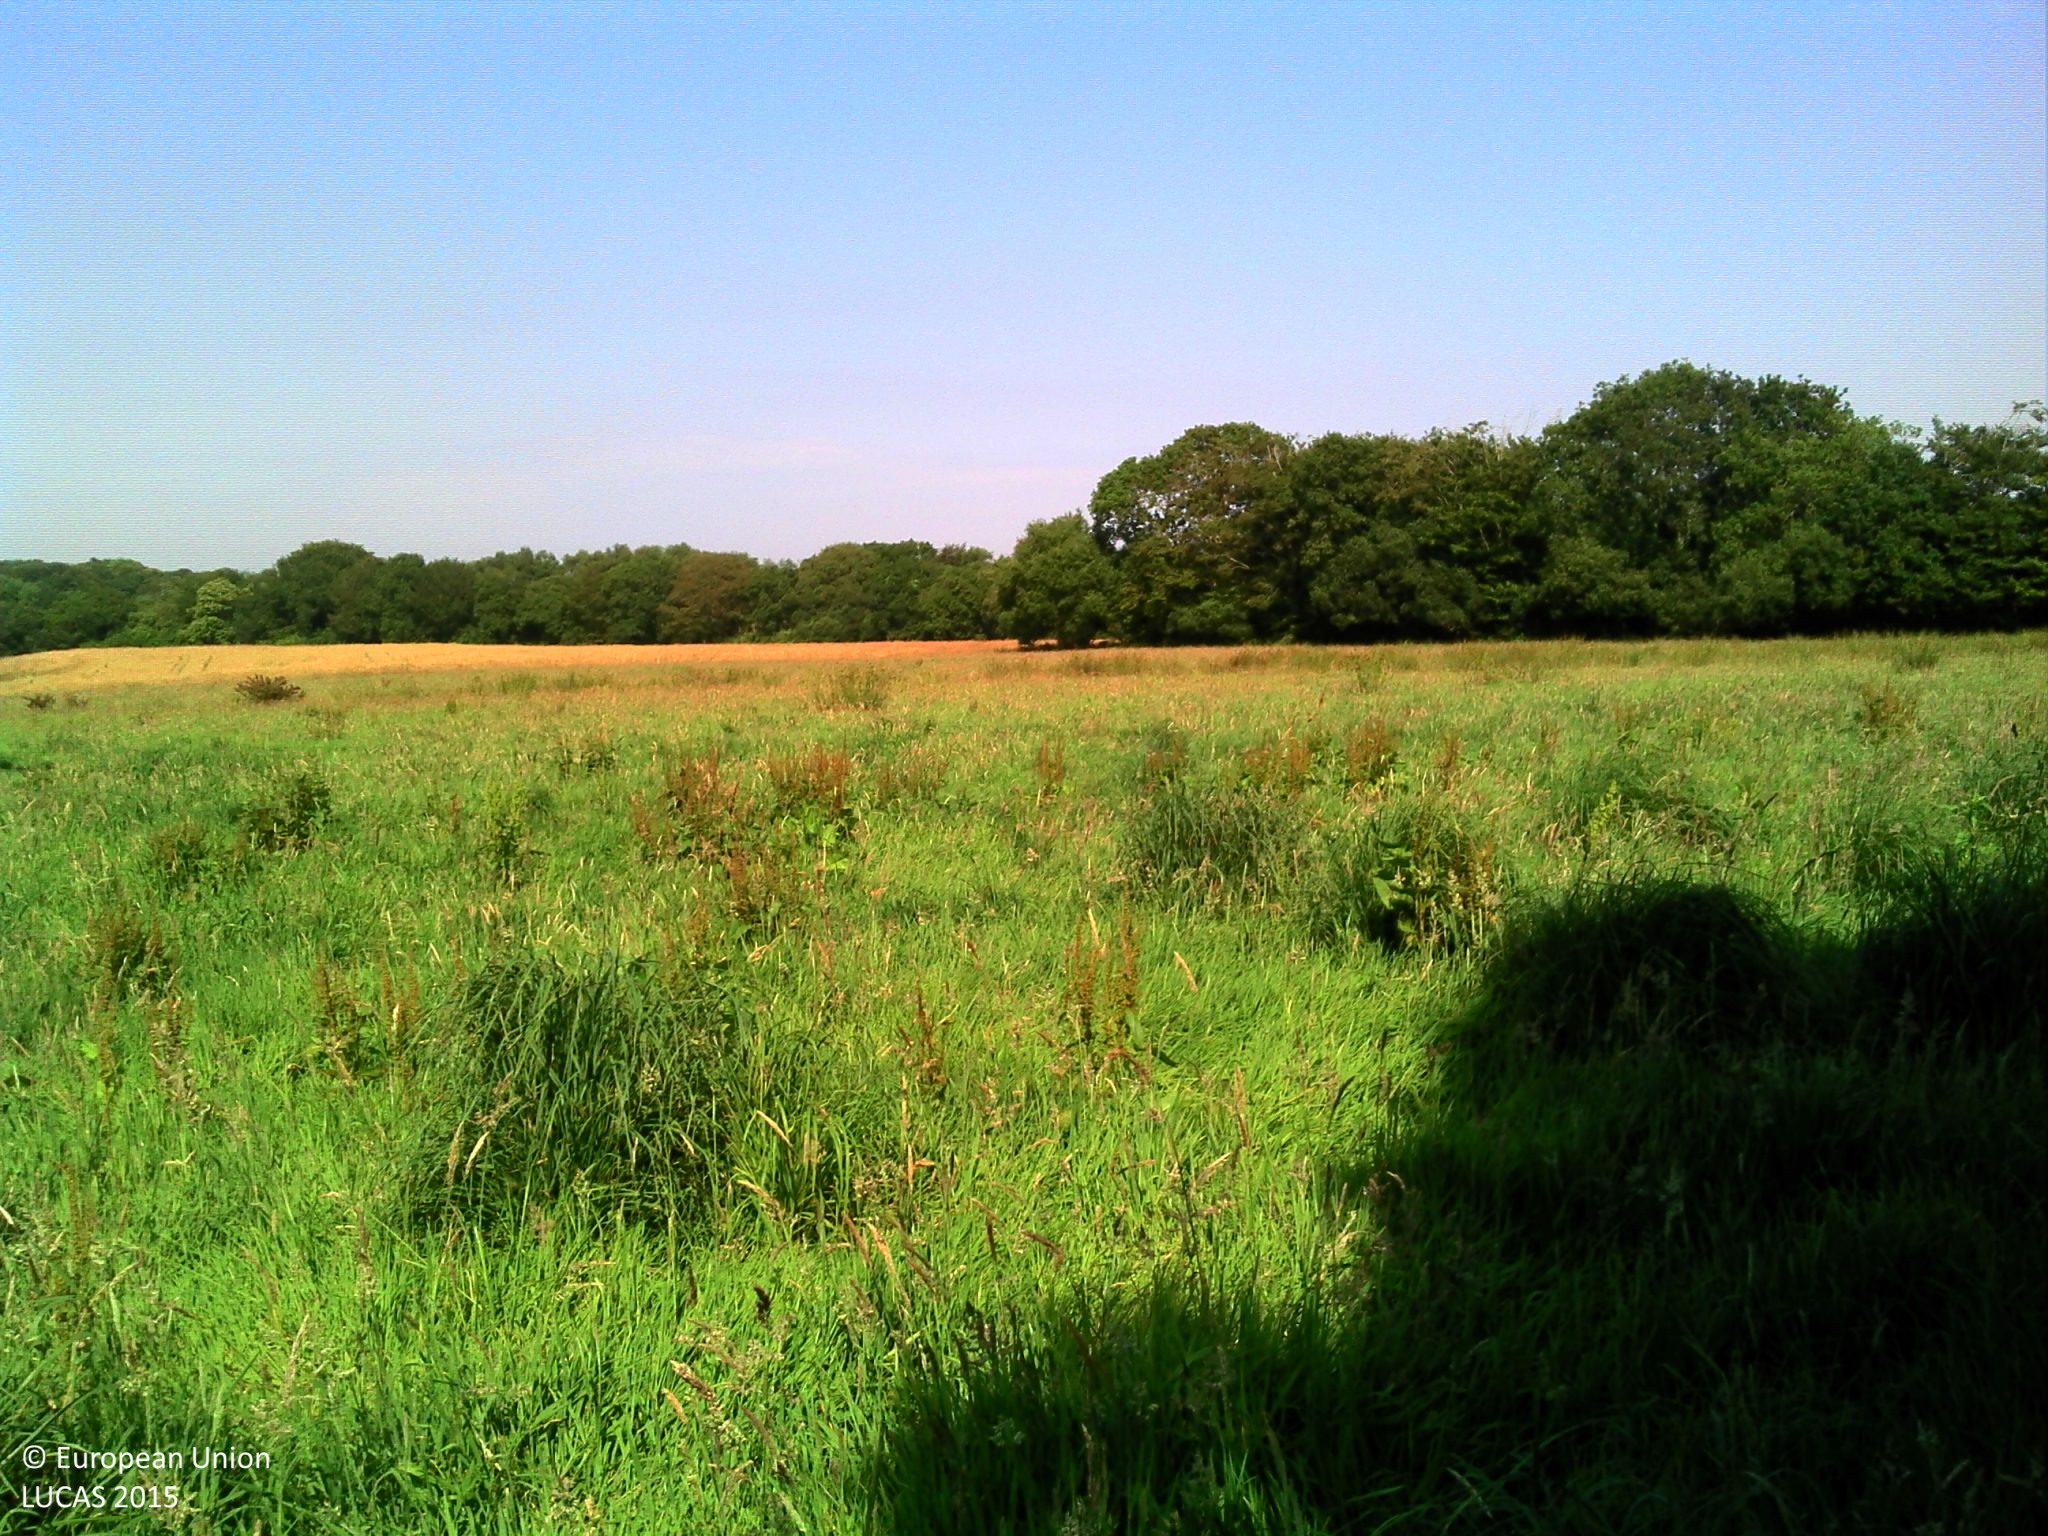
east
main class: Grassland
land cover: Grassland without tree/shrub cover
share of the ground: > 75 %
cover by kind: herbaceous plants 100 %
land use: Agriculture (excluding fallow land and kitchen gardens)
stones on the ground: < 10 %
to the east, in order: Grassland without tree/shrub cover; Fences; Grassland without tree/shrub cover; Broadleaved woodland; Maize; Broadleaved woodland; Grassland without tree/shrub cover; Fences; Grassland without tree/shrub cover
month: July
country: FR
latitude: 48.7767
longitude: -3.4836
